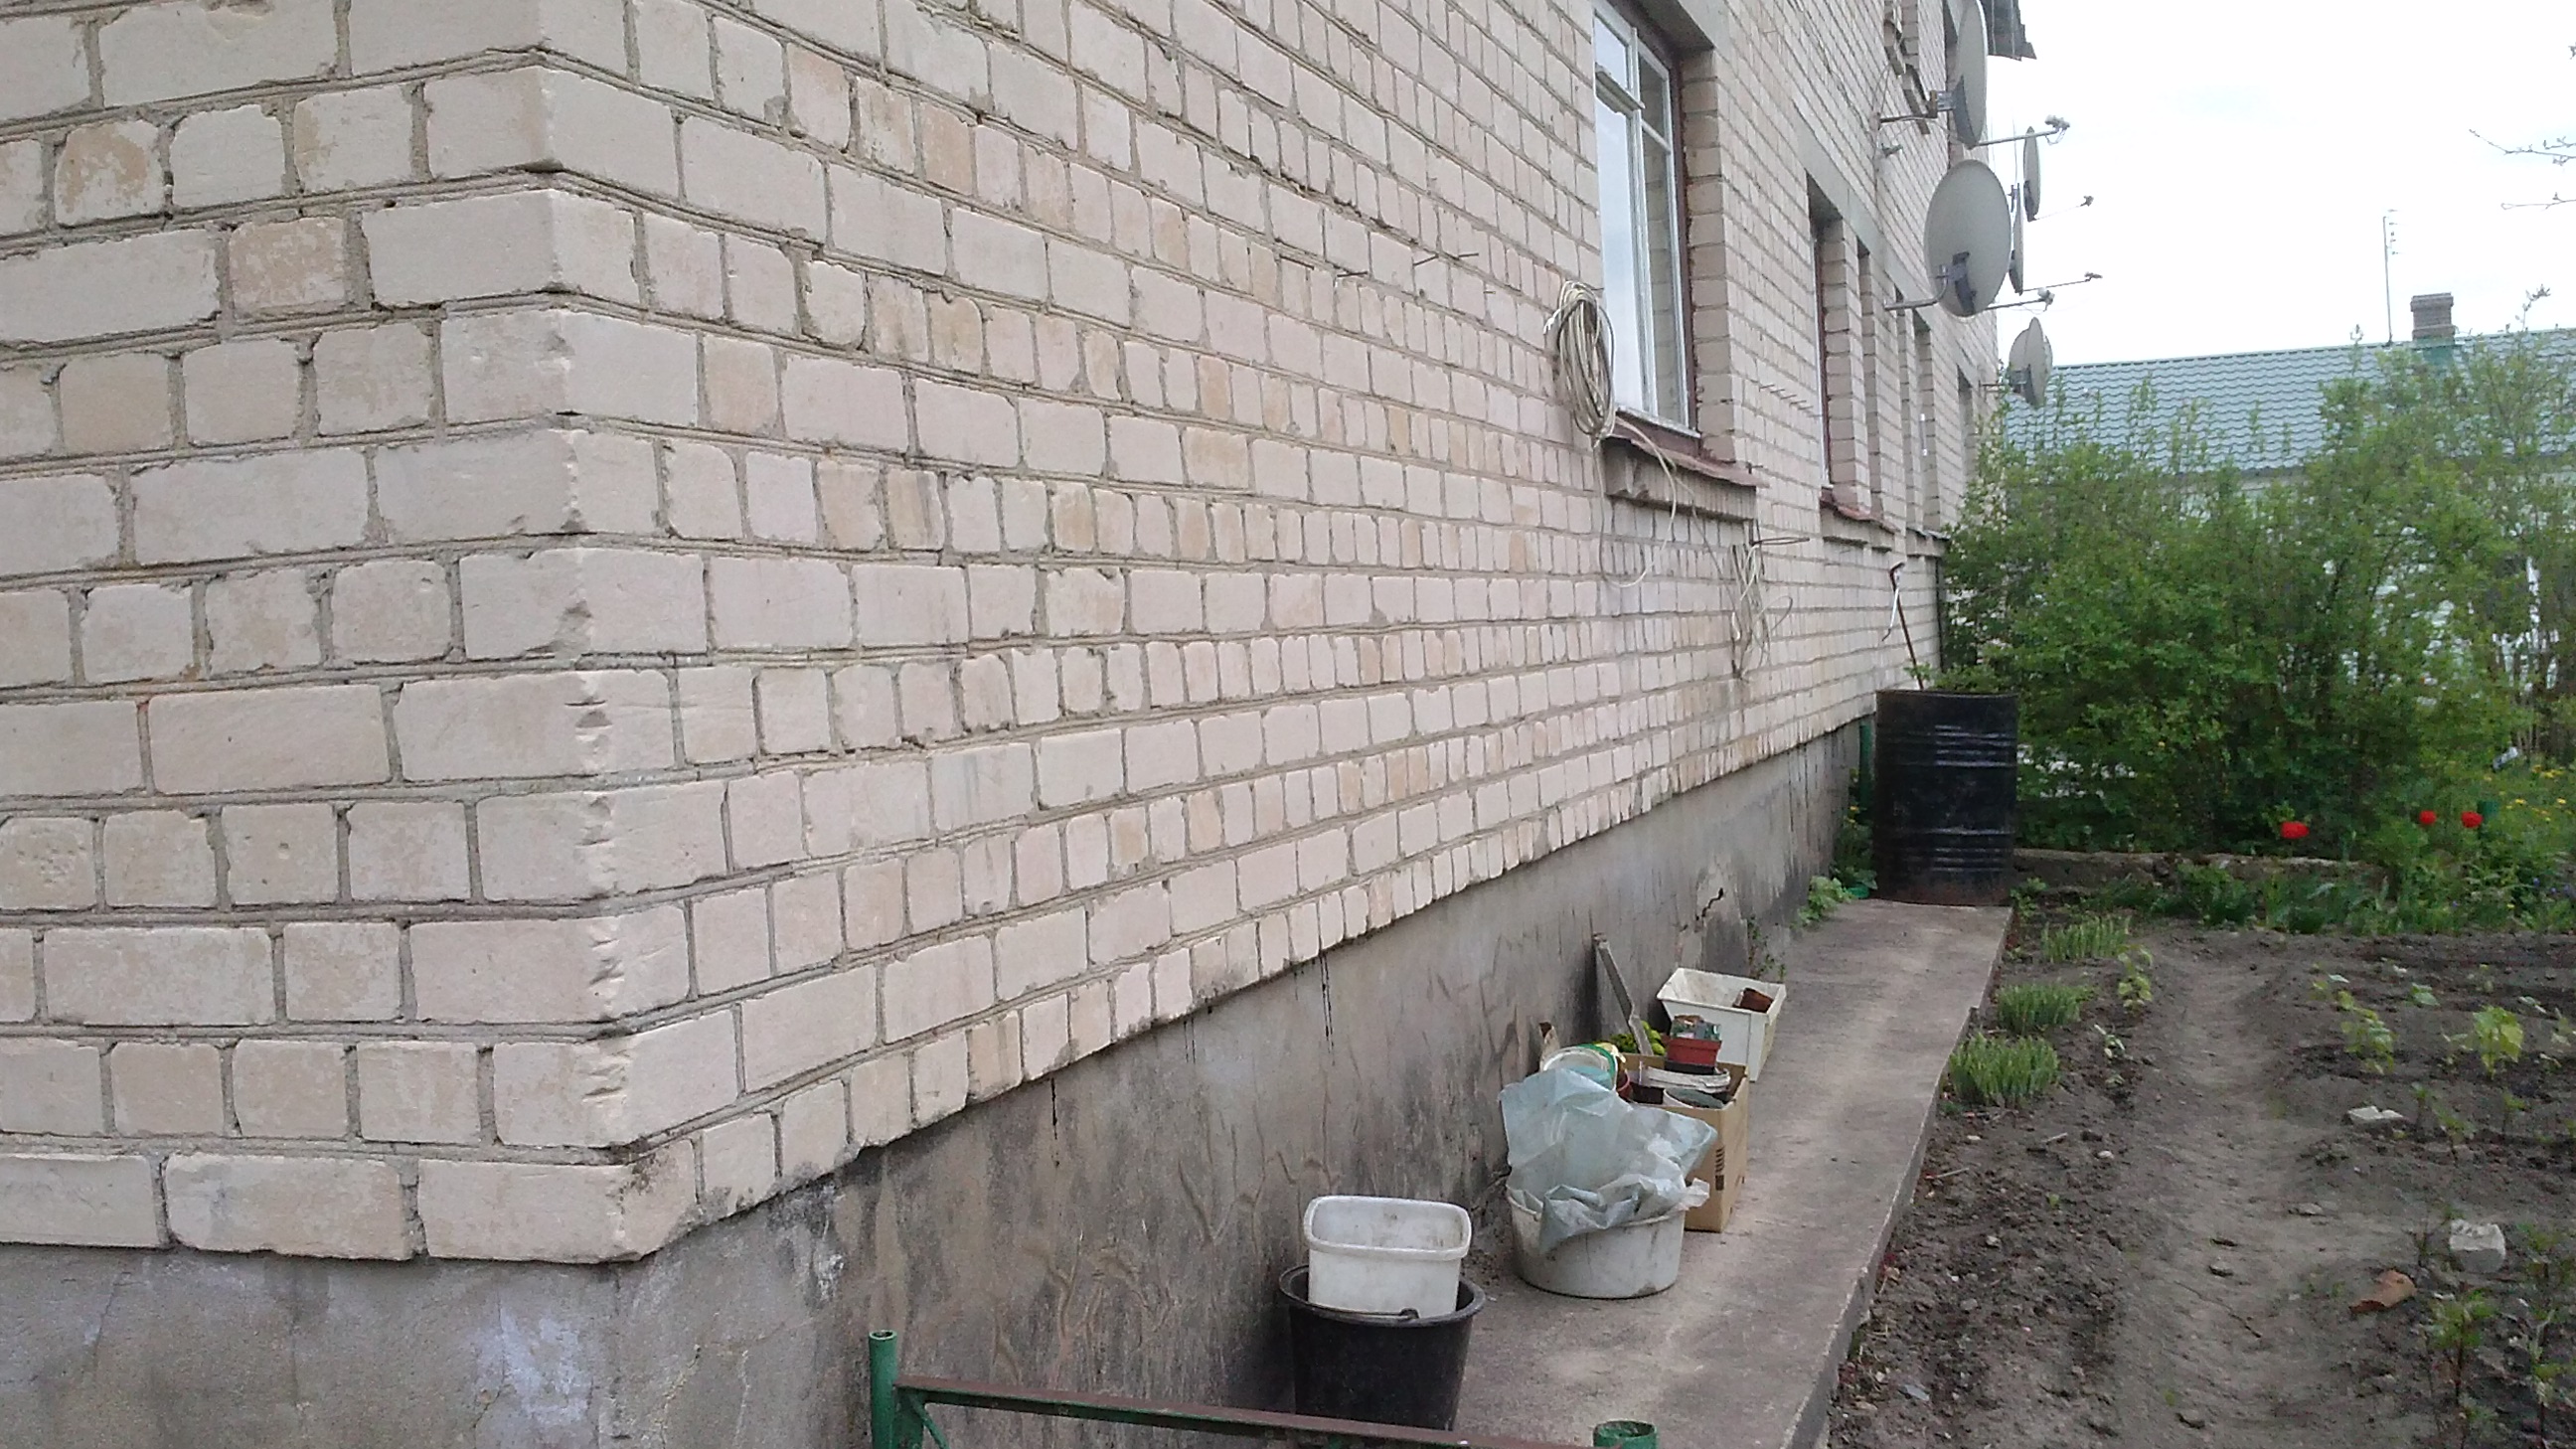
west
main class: Cropland
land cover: Floriculture and ornamental plants
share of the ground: > 75 %
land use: Kitchen garden
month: May
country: LV
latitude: 55.9231
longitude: 27.1496
